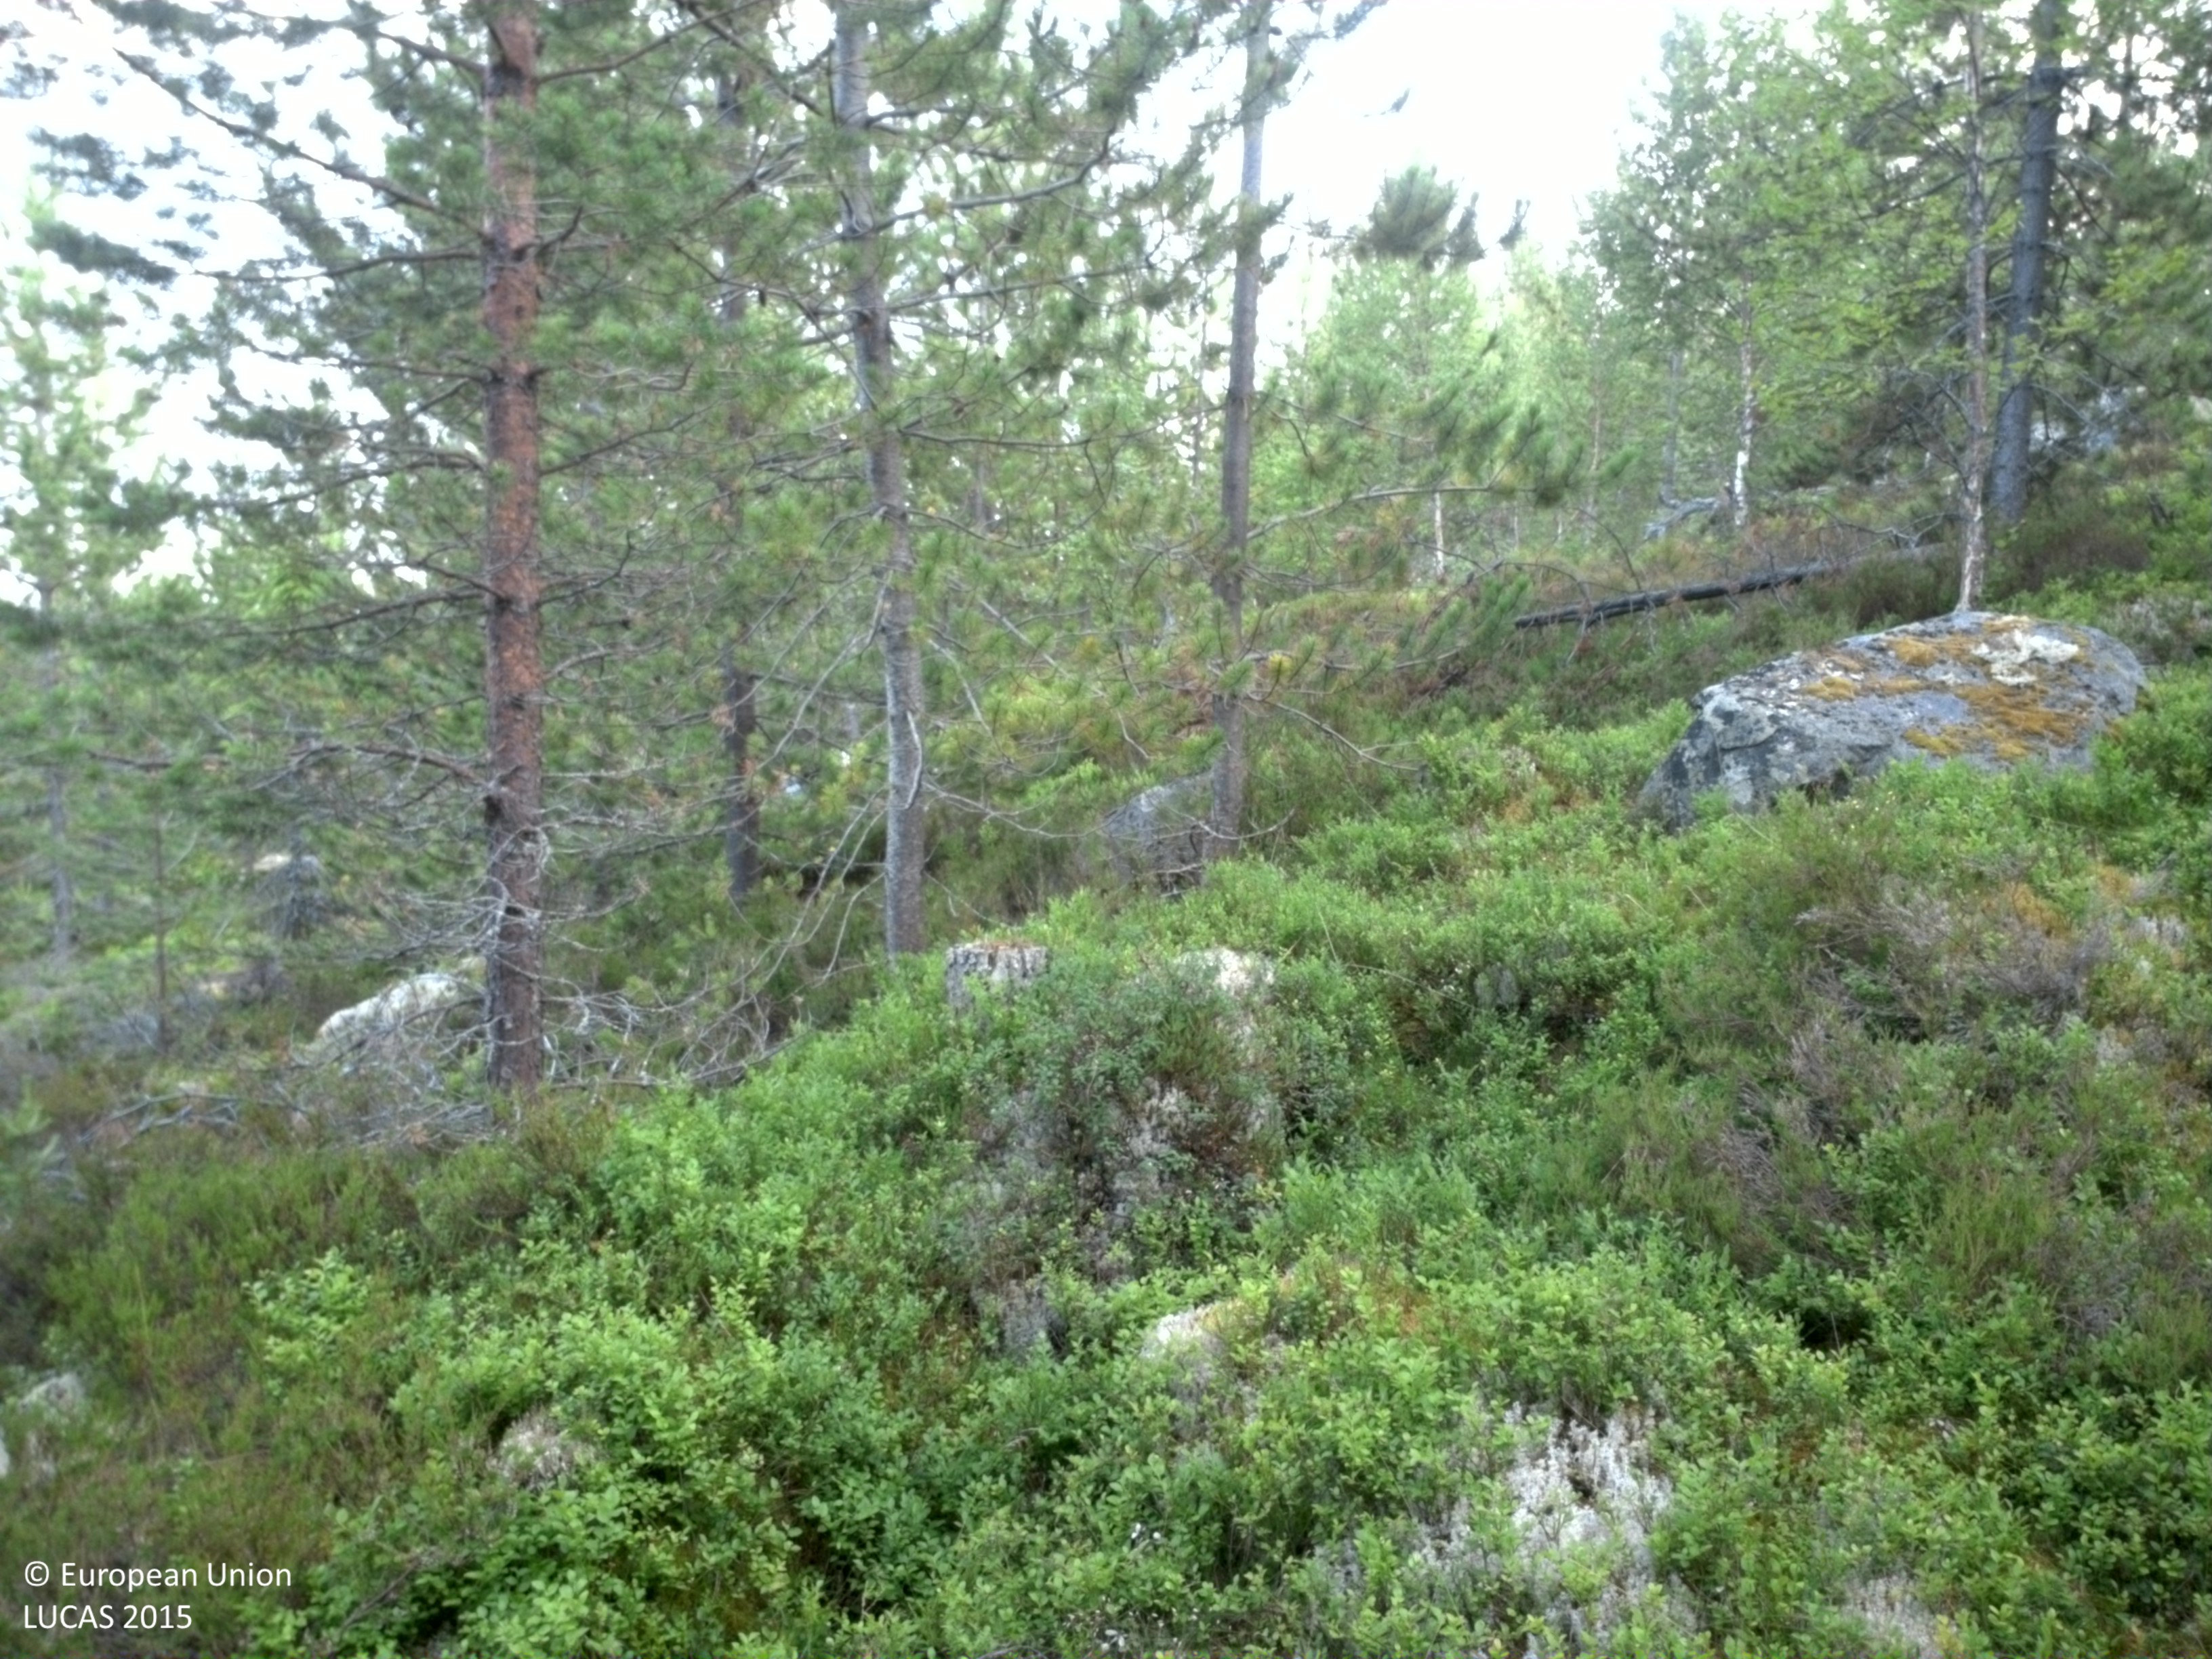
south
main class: Woodland
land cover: Pine dominated coniferous woodland
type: exotic forest
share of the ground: 50 - 75 %
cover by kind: coniferous forest trees 65 %, shrubs 35 %
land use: Forestry
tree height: < 5 m
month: August
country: SE
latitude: 61.9357
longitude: 14.3472
